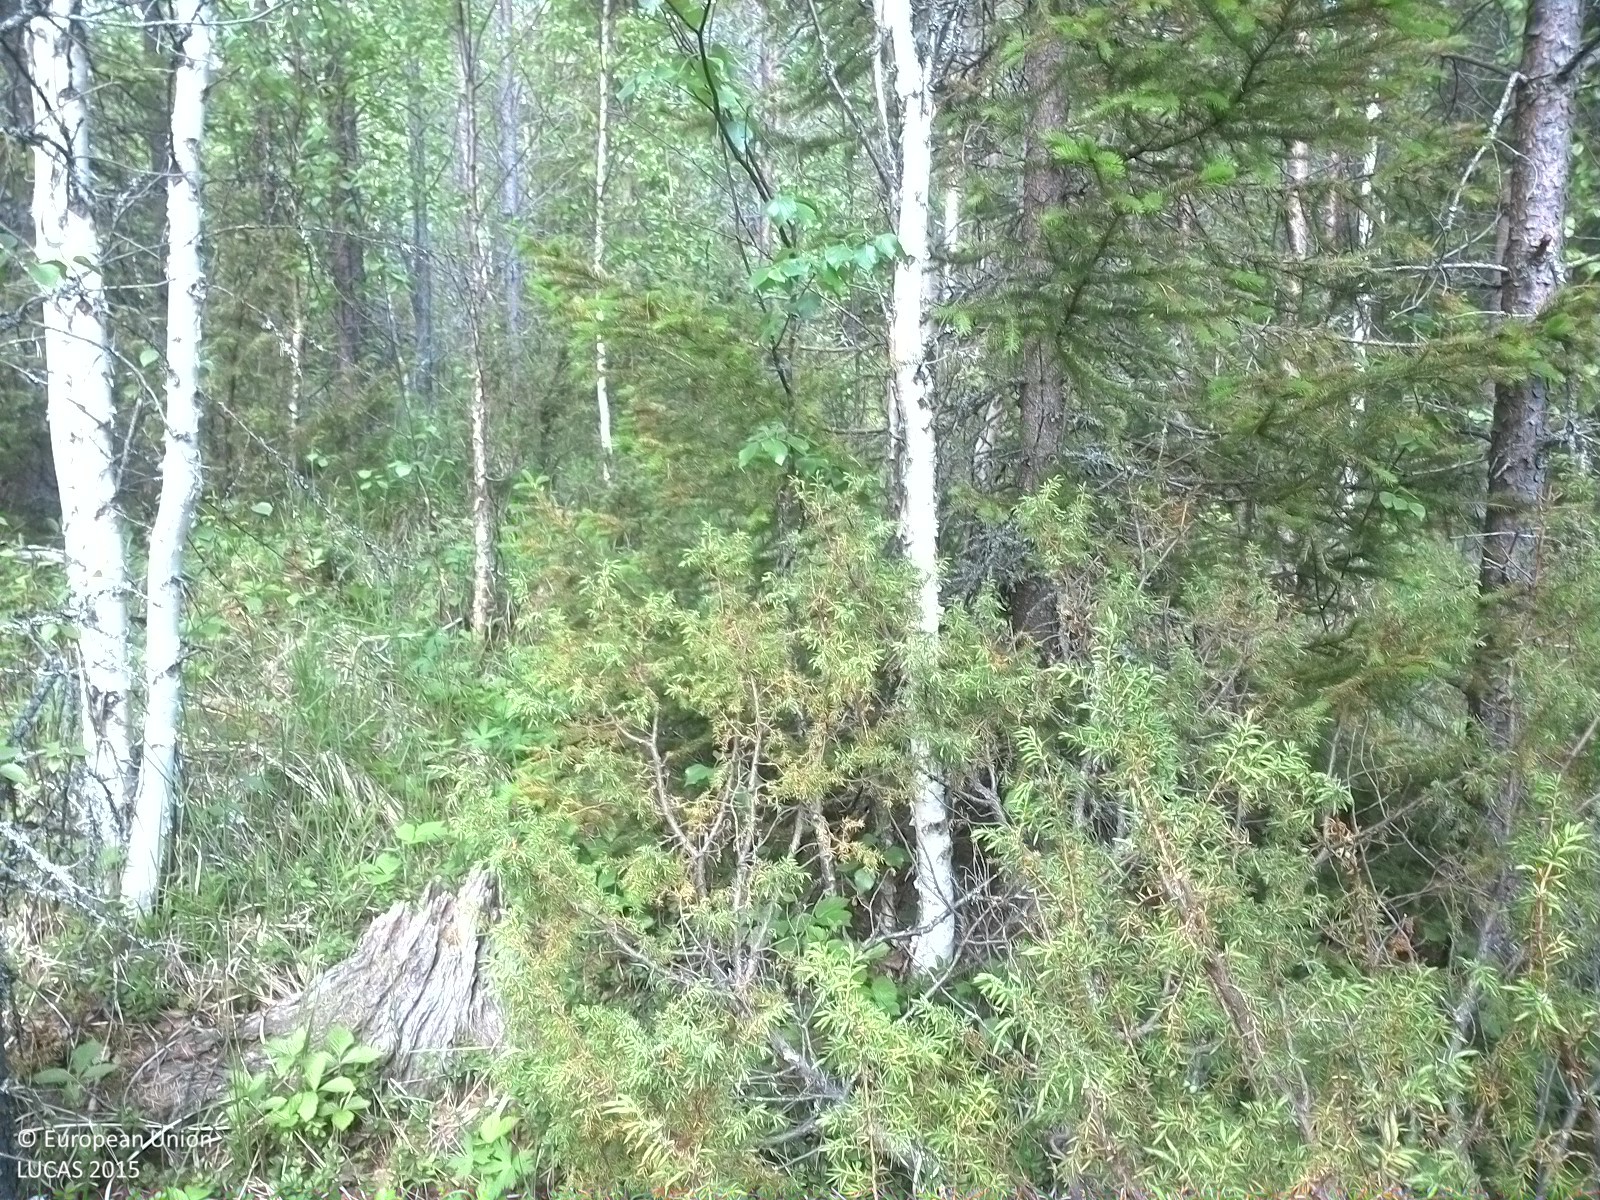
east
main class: Woodland
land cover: Other mixed woodland
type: boreal forest
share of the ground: > 75 %
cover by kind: coniferous forest trees 60 %, broadleaved forest trees 20 %, herbaceous plants 20 %
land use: Forestry
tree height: > 5 m
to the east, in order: Other mixed woodland; Broadleaved woodland; Spruce dominated coniferous woodland; Shrubland with sparse tree cover; Spruce dominated mixed woodland; Ditches and canals; Grassland without tree/shrub cover; Ditches and canals; Other mixed woodland
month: June
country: SE
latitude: 63.6199
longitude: 15.3609
